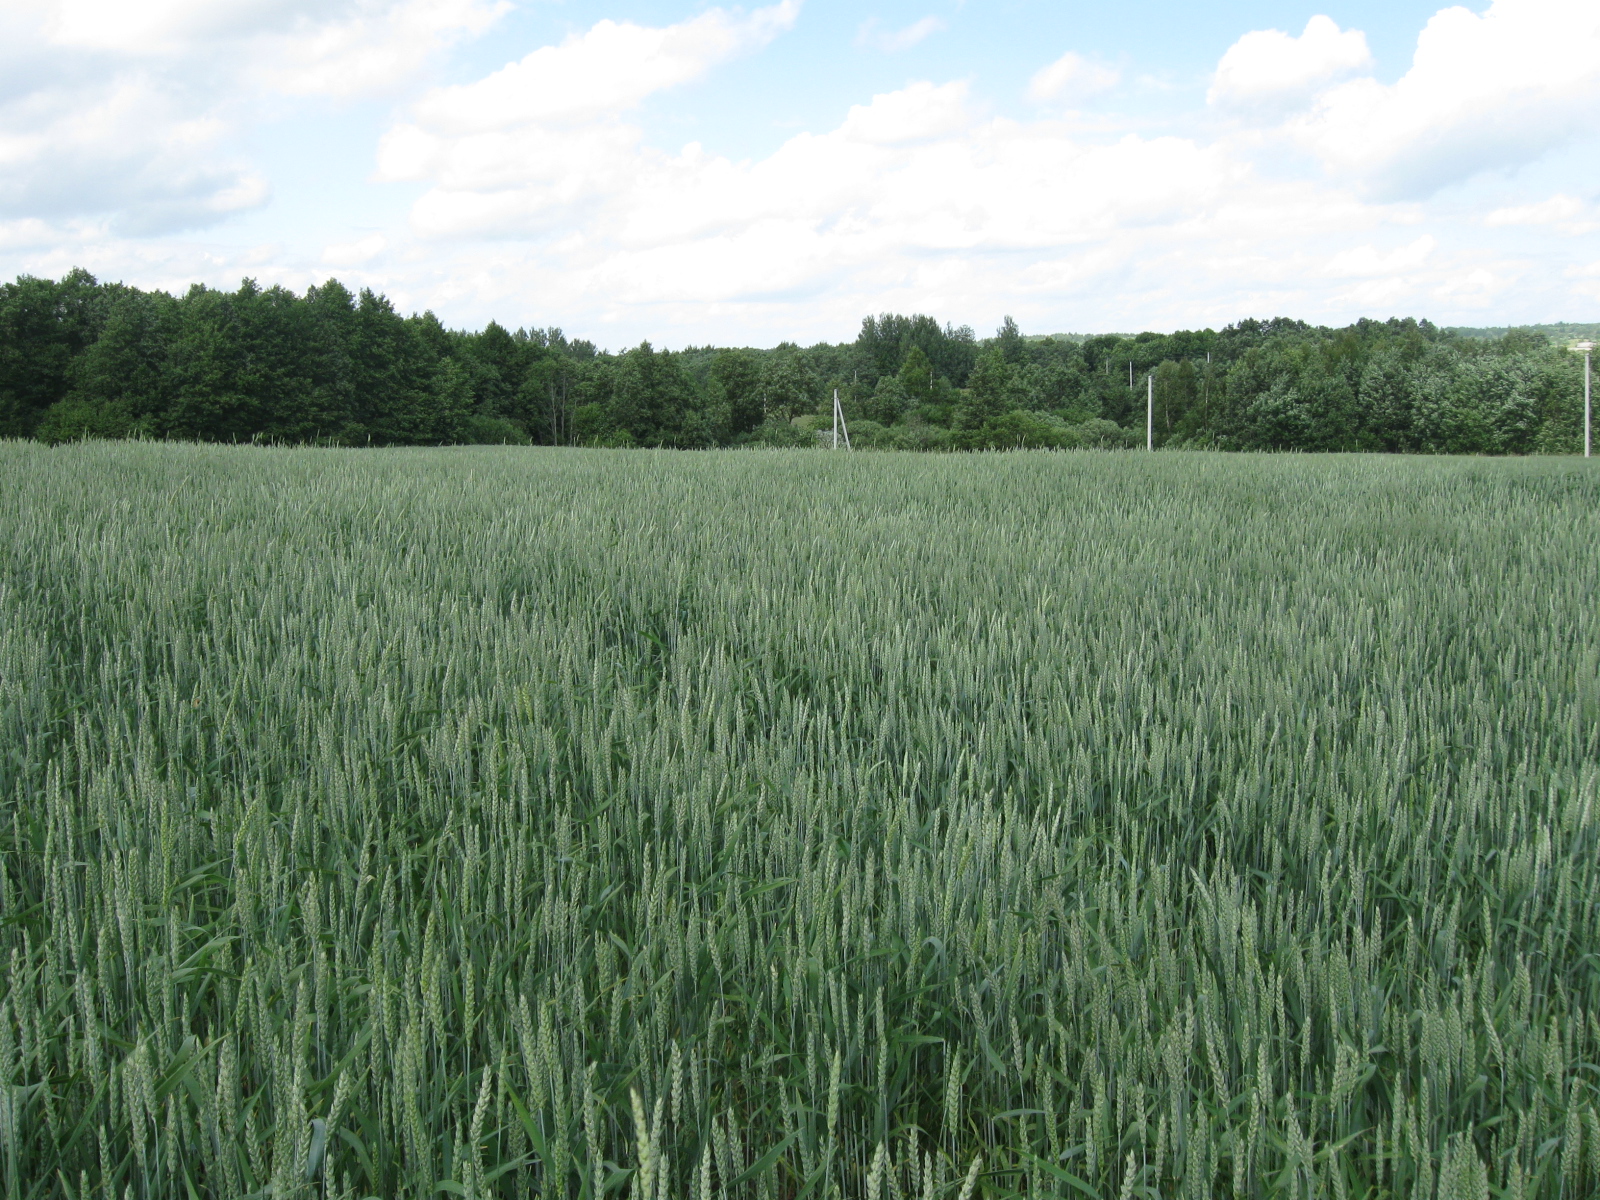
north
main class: Cropland
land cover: Common wheat
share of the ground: > 75 %
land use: Agriculture (excluding fallow land and kitchen gardens)
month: June
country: LT
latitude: 54.6516
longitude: 24.4377
